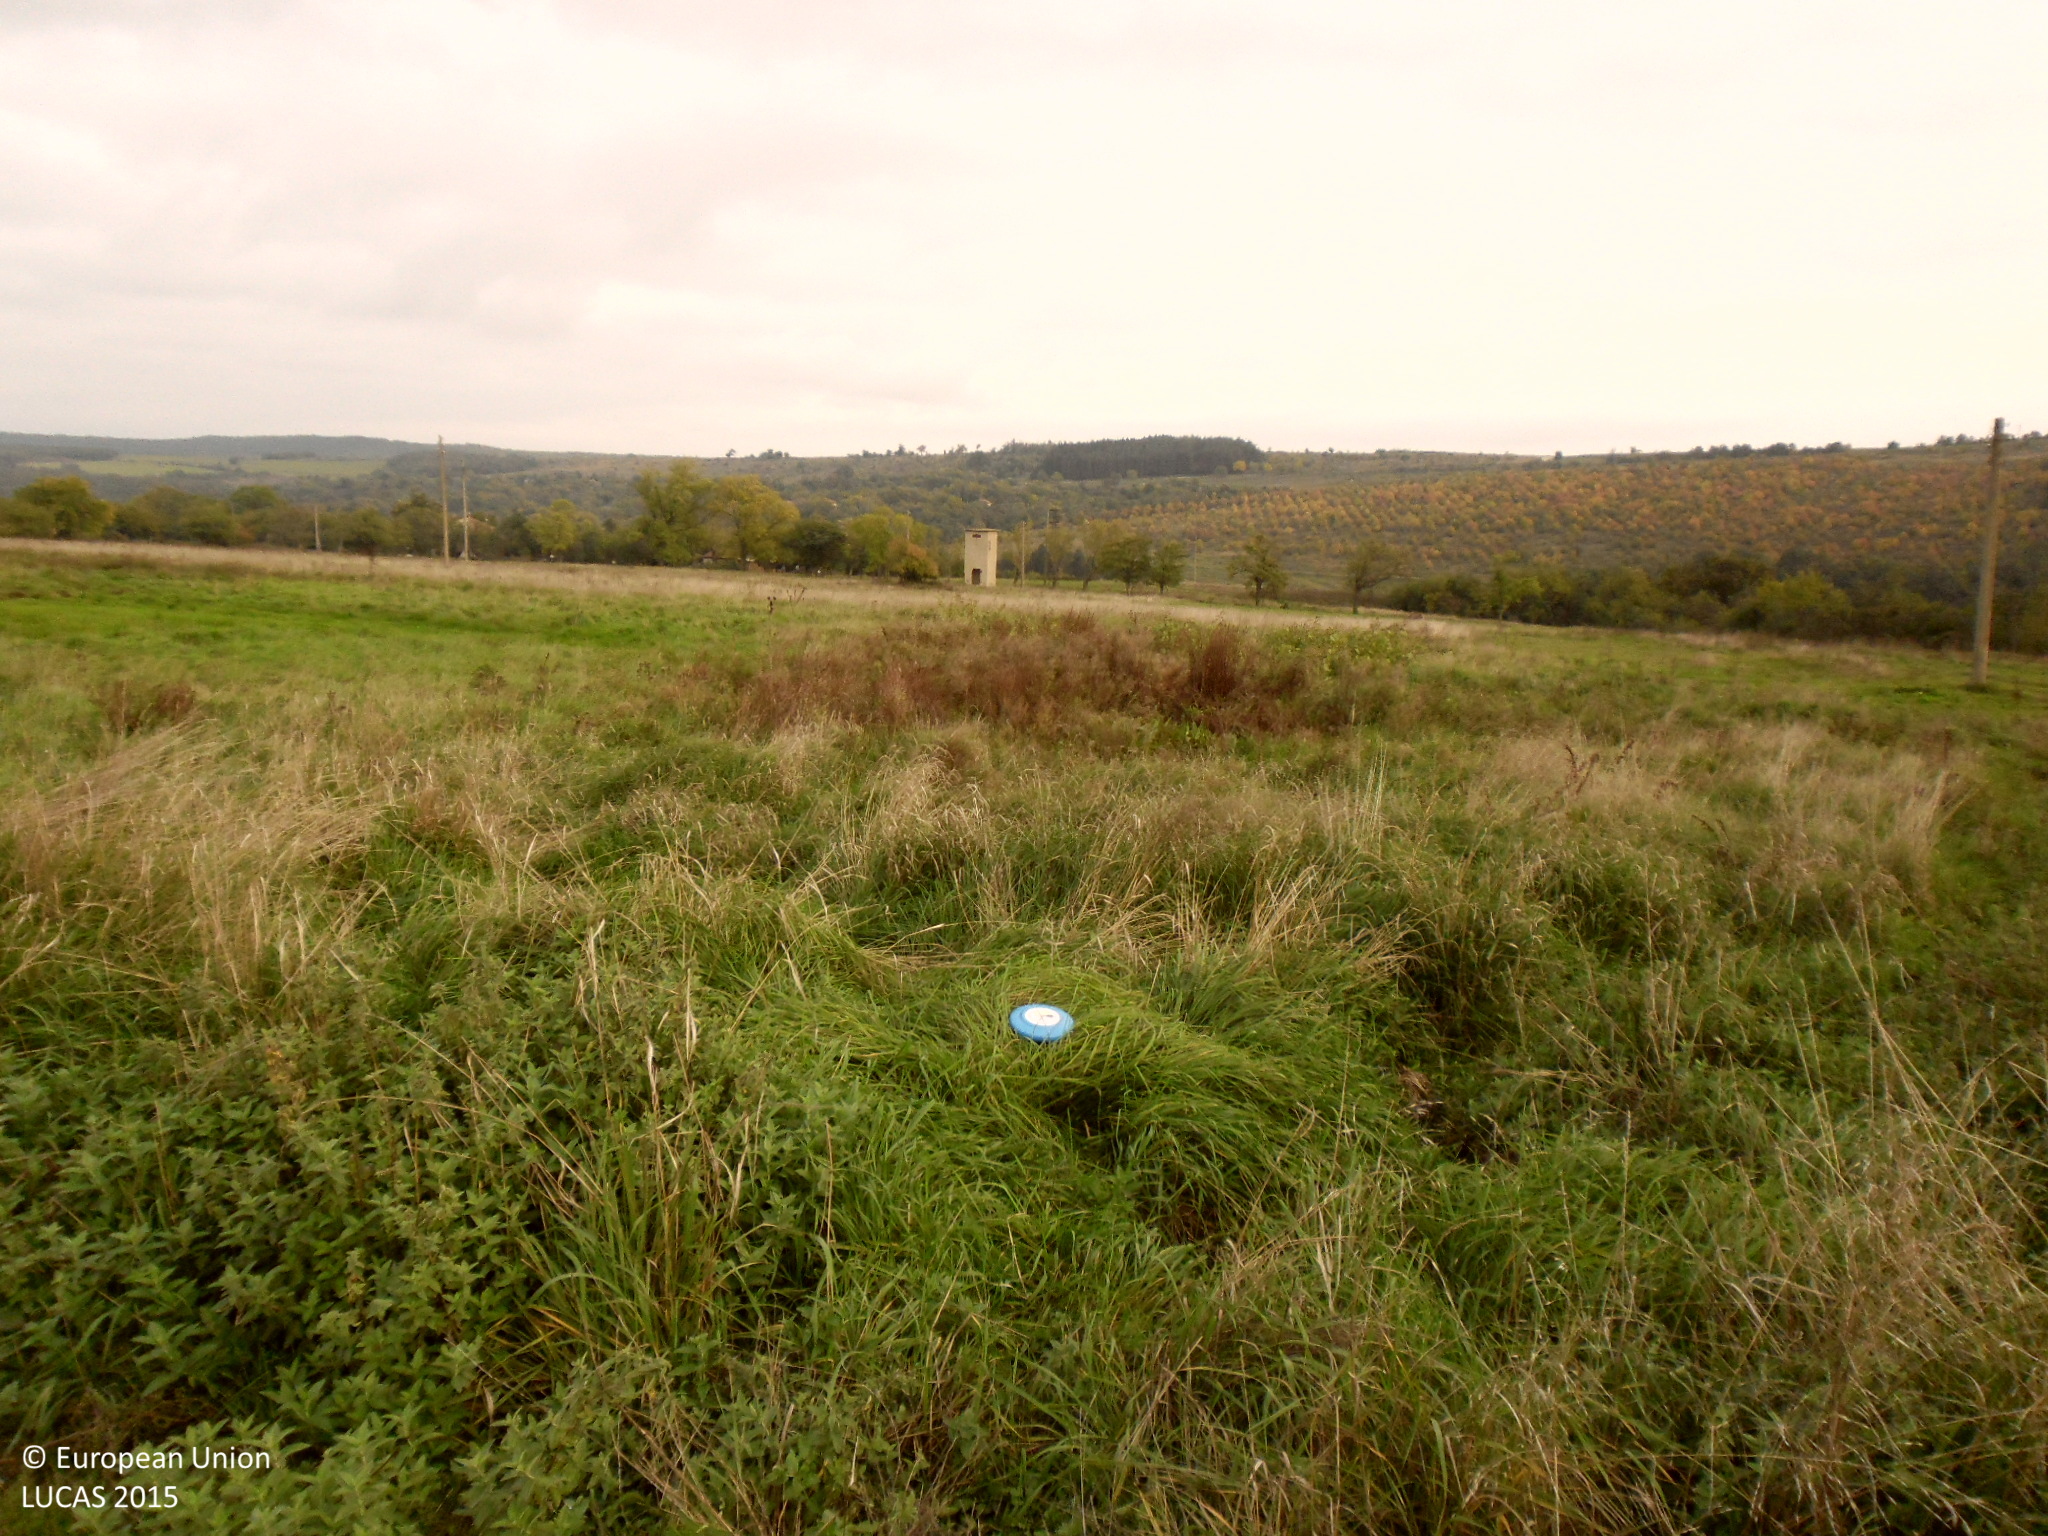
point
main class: Grassland
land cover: Grassland without tree/shrub cover
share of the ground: > 75 %
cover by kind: herbaceous plants 100 %
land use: Agriculture (excluding fallow land and kitchen gardens)
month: October
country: BG
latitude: 43.8308
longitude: 22.4809
